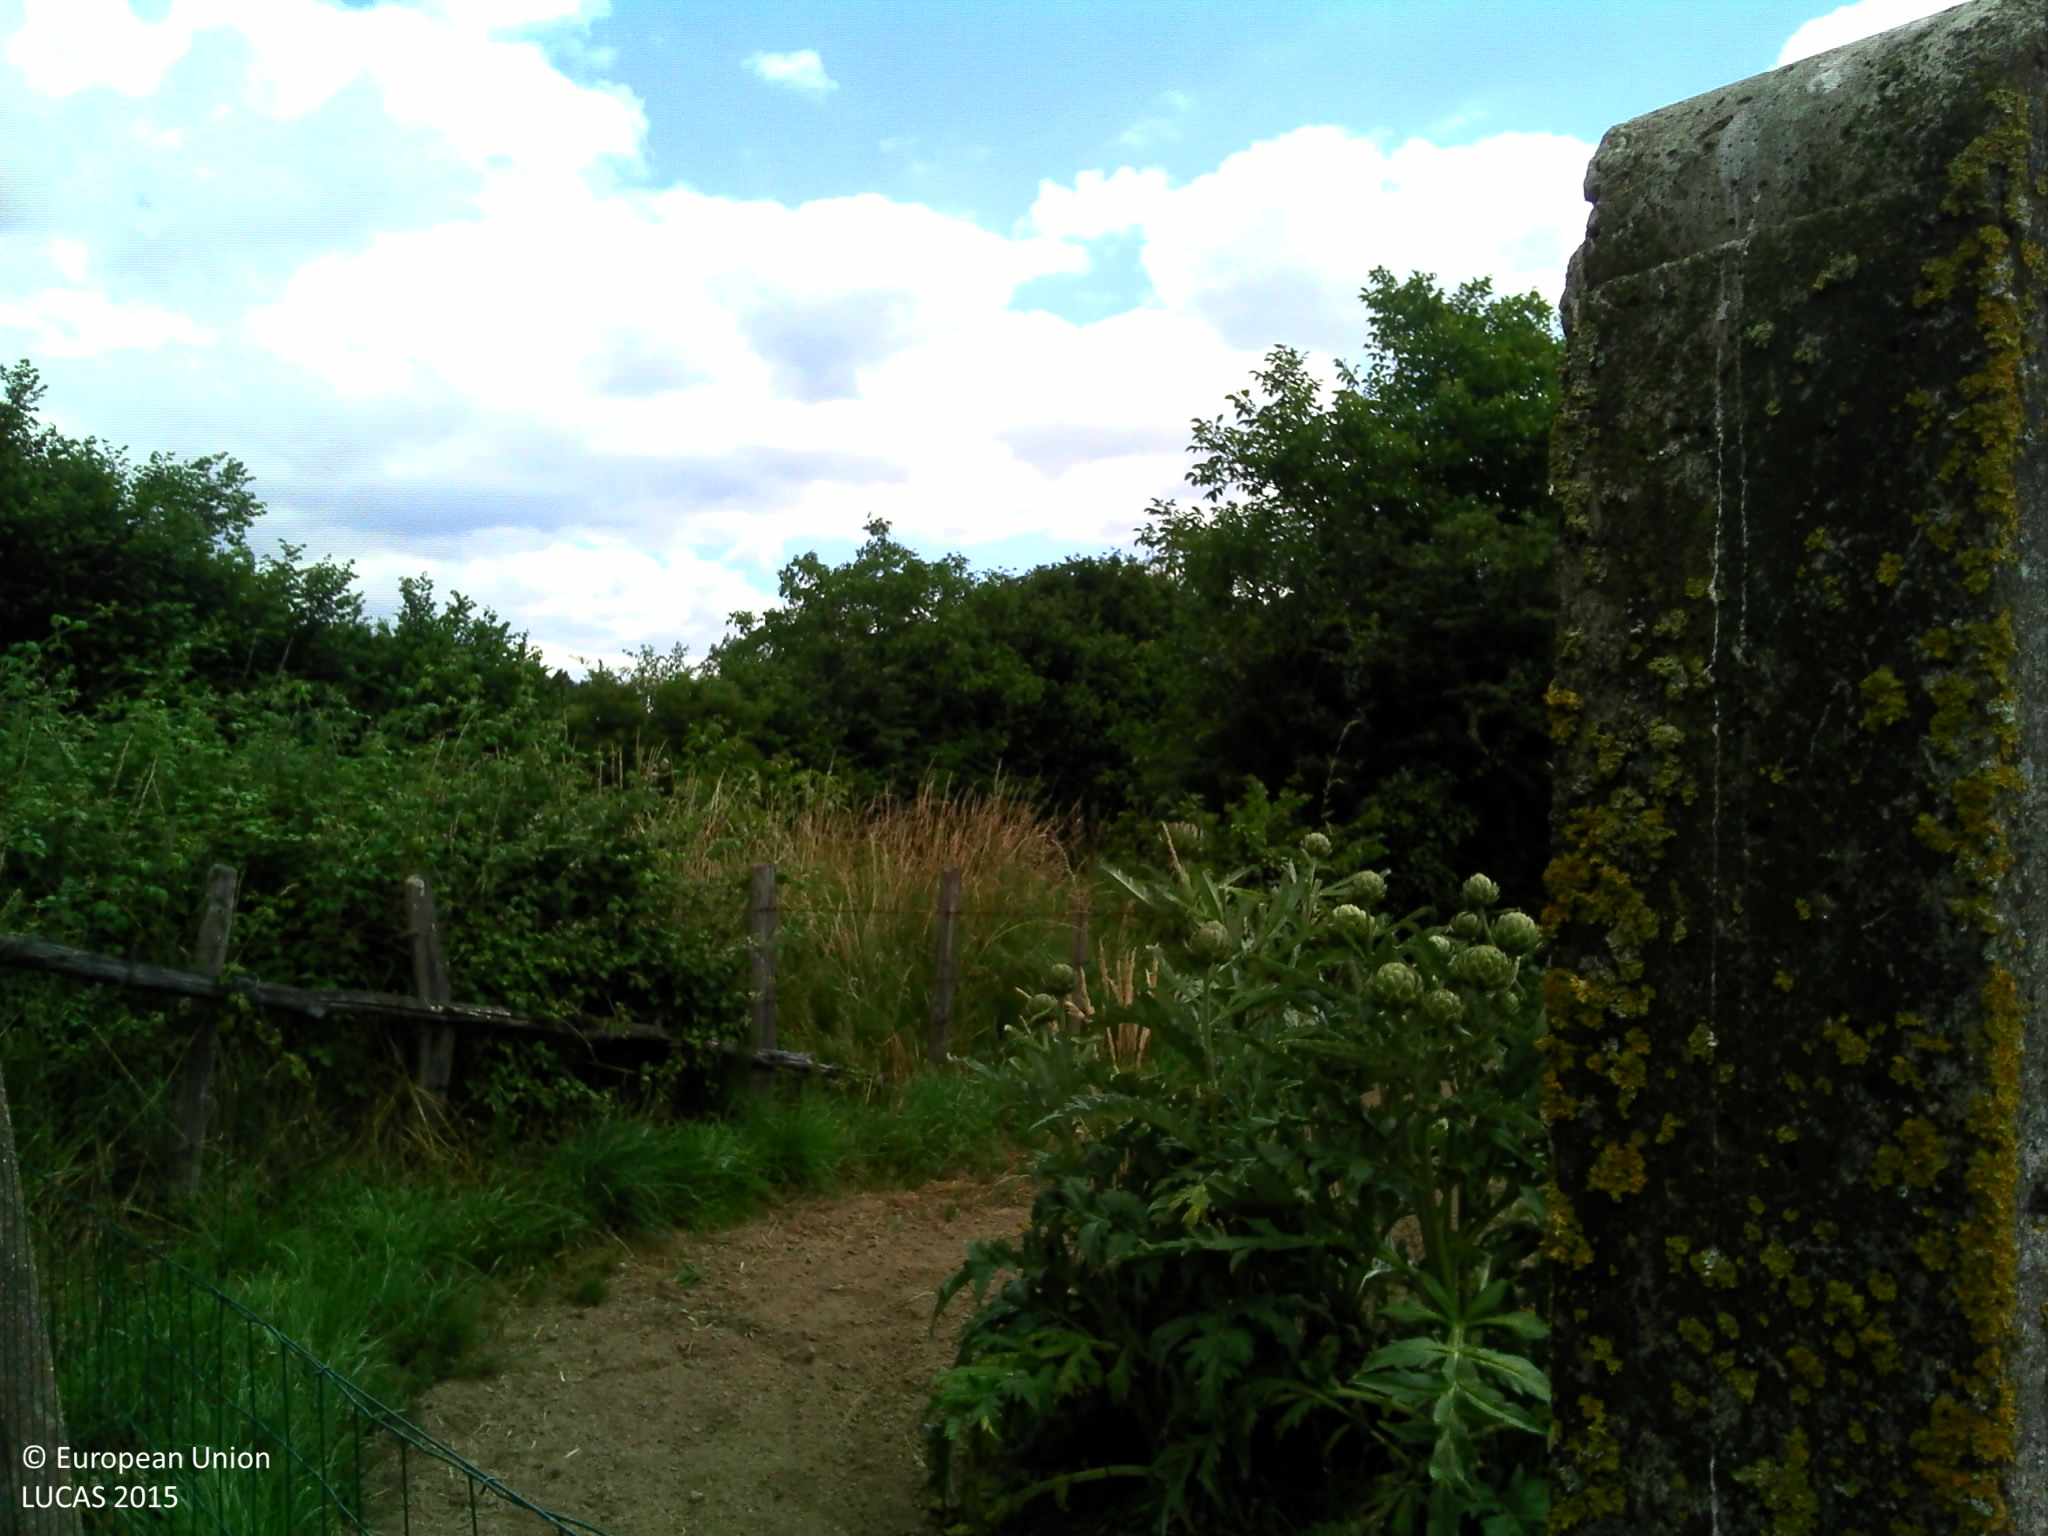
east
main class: Cropland
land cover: Potatoes
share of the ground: > 75 %
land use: Kitchen garden
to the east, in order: Potatoes; Fences; Managed hedges; Ditches and canals; Electric lines; Railways; Ditches and canals; Lines of trees; Fences; Grassland without tree/shrub cover; Artificial constructions in urban areas; Grassland without tree/shrub cover; Single bushes/trees; Fences; Grass margins; Paved roads, cycling and walking lanes; Ditches and canals; Abandoned hedges
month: June
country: FR
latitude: 47.8279
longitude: 0.2637
